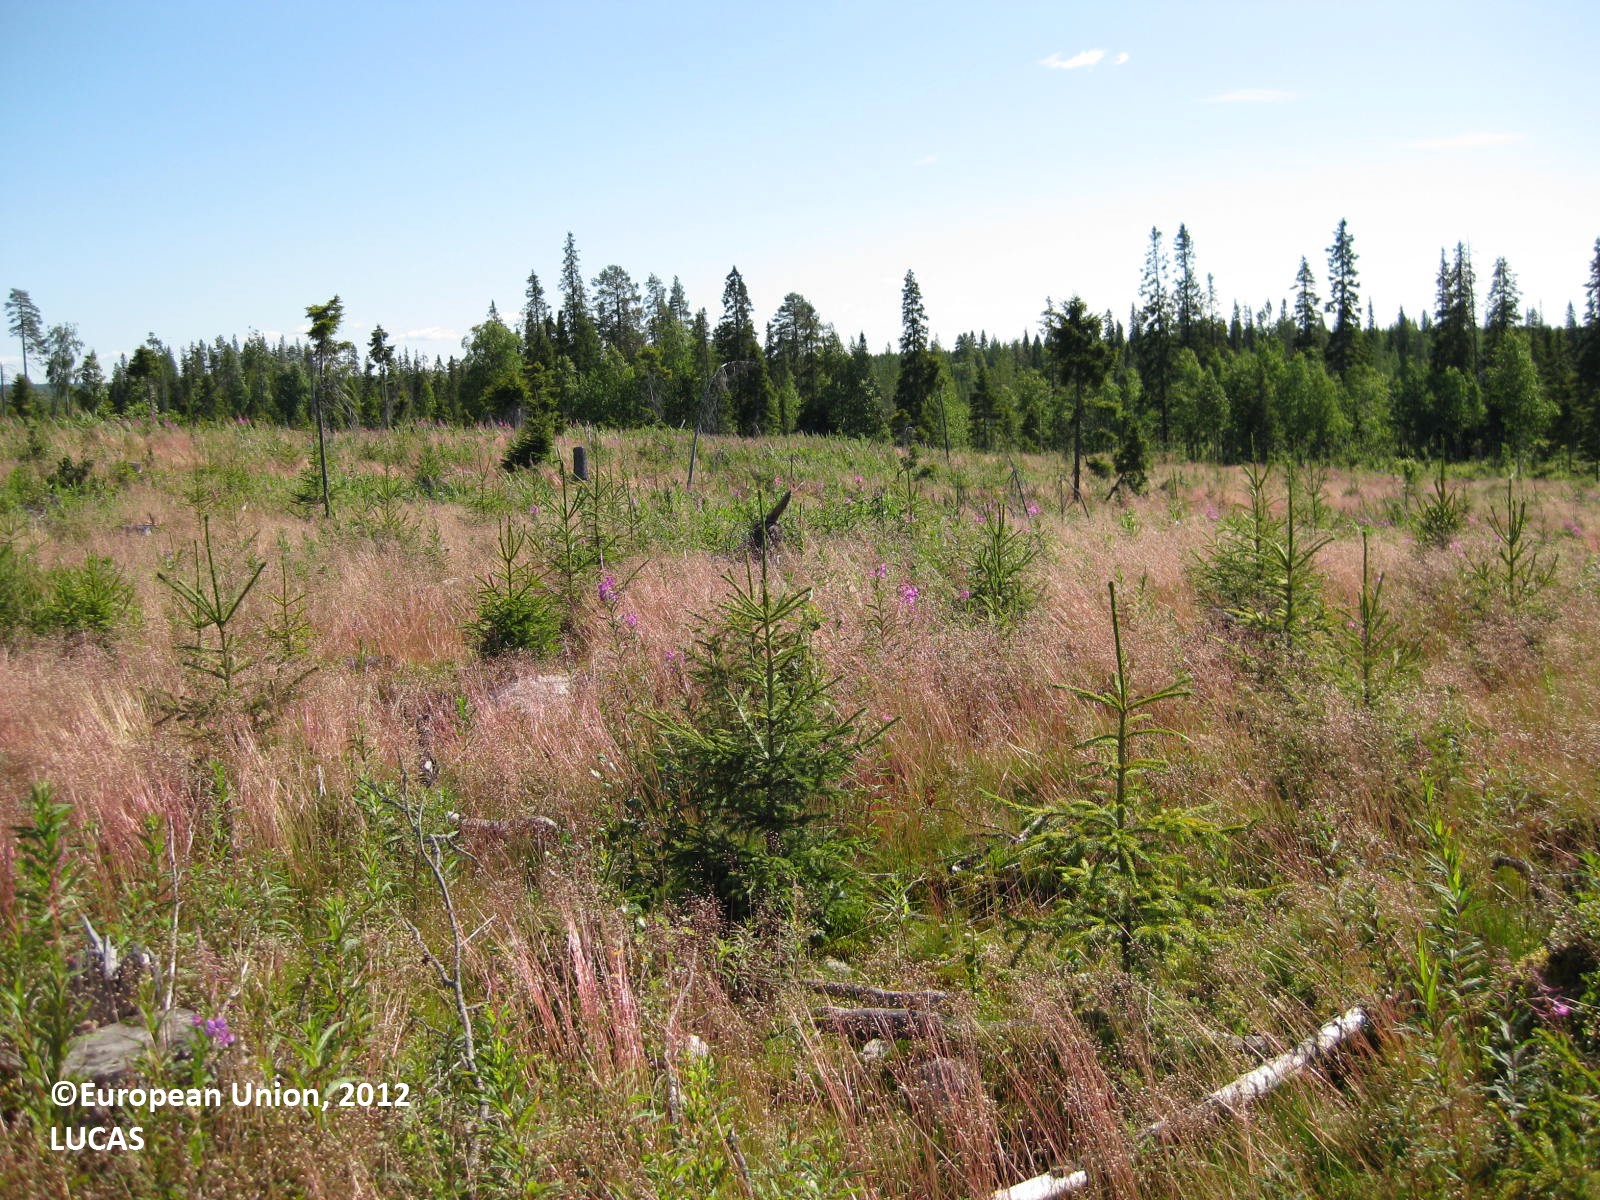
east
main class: Woodland
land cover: Spruce dominated coniferous woodland
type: boreal forest
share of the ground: 10 - 25 %
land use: Forestry
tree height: < 5 m
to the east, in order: Spruce dominated coniferous woodland; Spruce dominated mixed woodland; Spruce dominated coniferous woodland; Spruce dominated mixed woodland
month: July
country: FI
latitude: 65.5995
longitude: 28.4461
